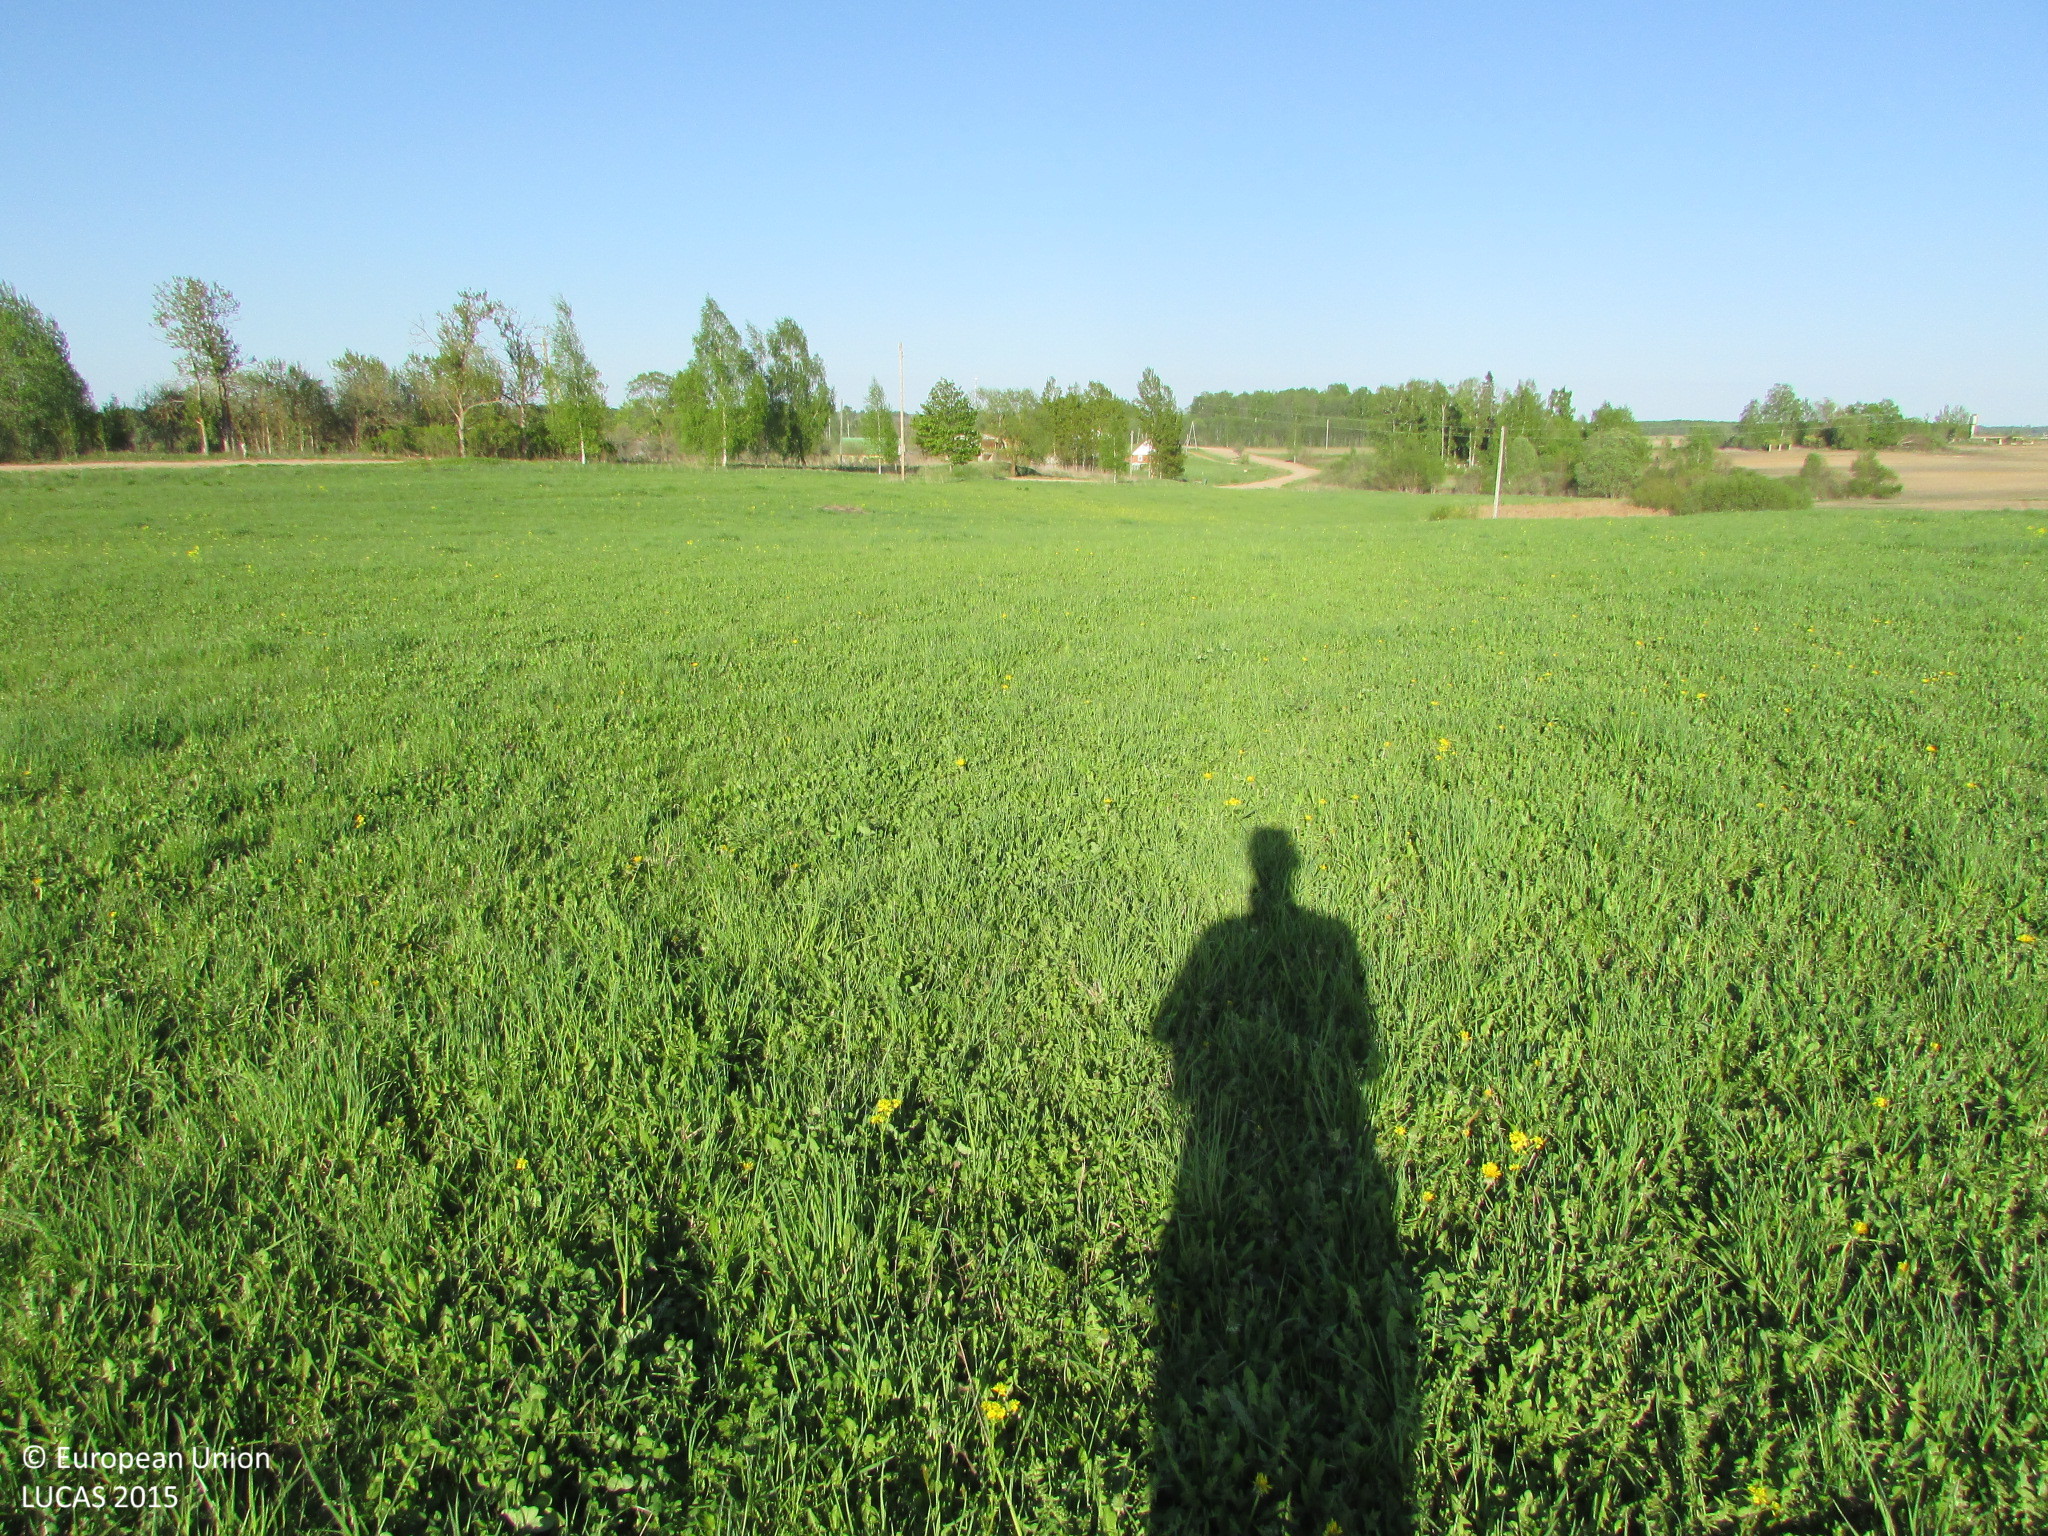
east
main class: Grassland
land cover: Grassland without tree/shrub cover
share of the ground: > 75 %
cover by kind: herbaceous plants 100 %
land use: Agriculture (excluding fallow land and kitchen gardens)
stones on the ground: < 10 %
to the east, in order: Grassland without tree/shrub cover; Electric lines; Grassland without tree/shrub cover; Paved roads, cycling and walking lanes; Grassland without tree/shrub cover; Broadleaved woodland
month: May
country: LV
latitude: 55.8758
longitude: 27.4920
